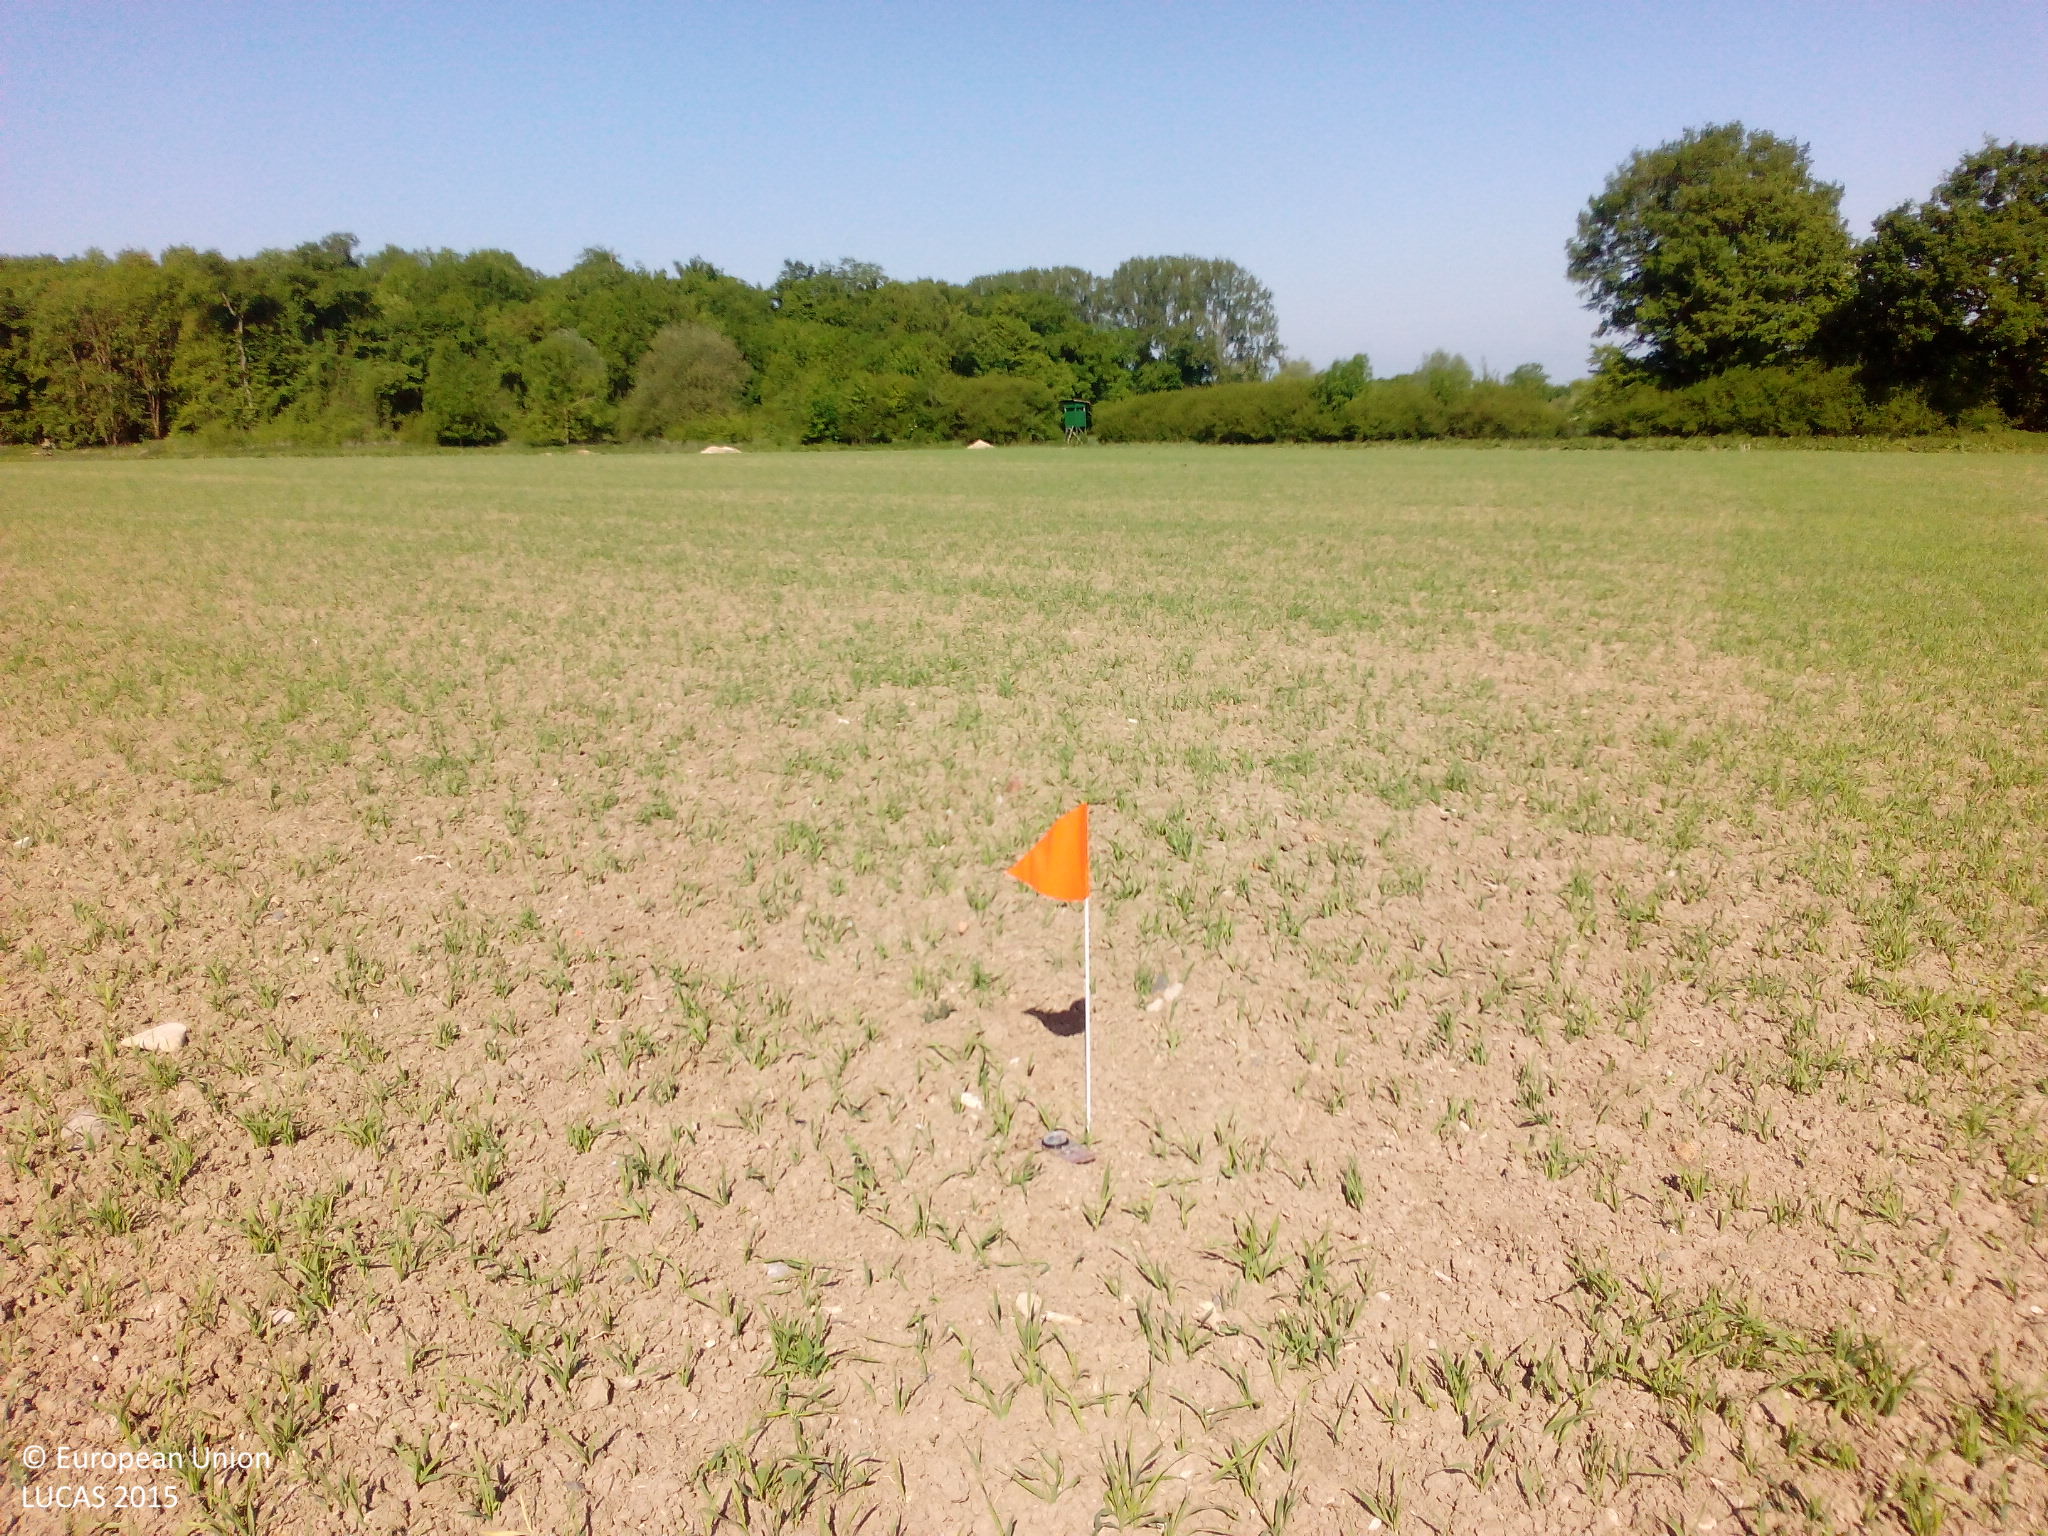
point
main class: Cropland
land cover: Common wheat
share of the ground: 25 - 50 %
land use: Agriculture (excluding fallow land and kitchen gardens)
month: May
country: DE
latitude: 51.8749
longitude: 7.9814
